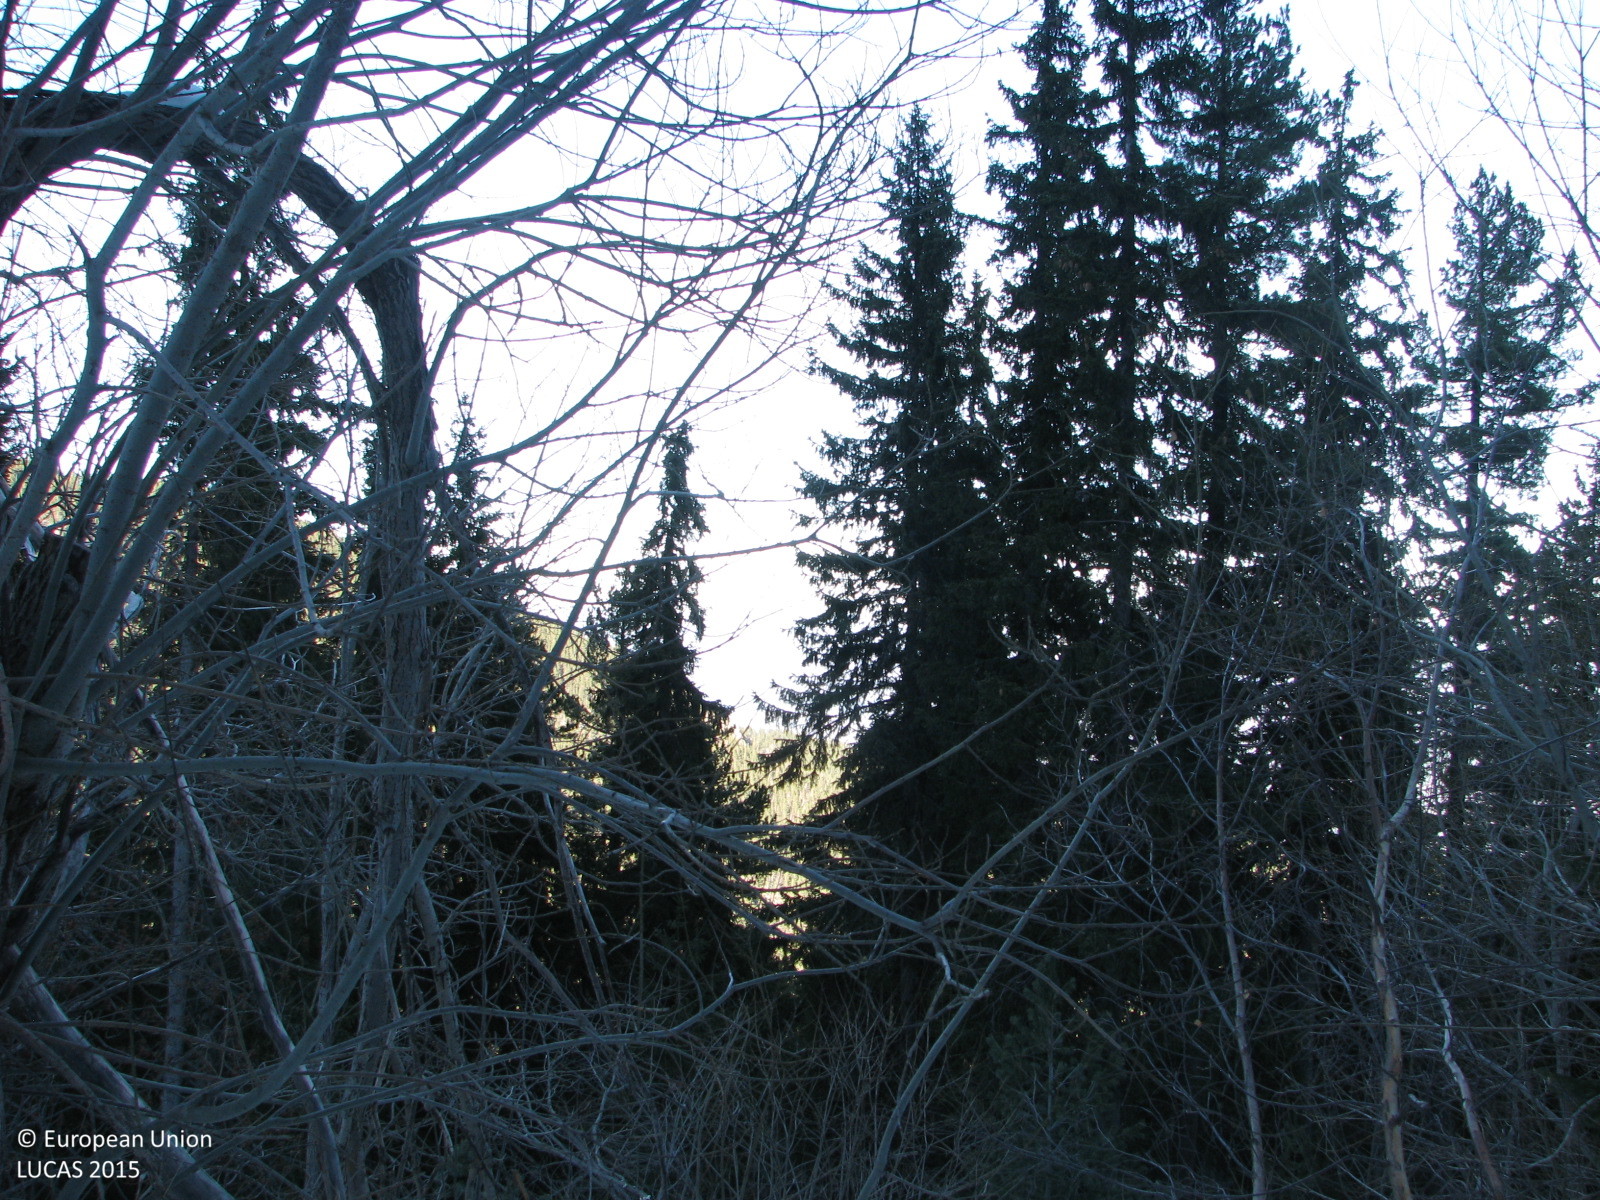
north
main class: Woodland
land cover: Spruce dominated mixed woodland
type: hemiboreal forest and nemoral coniferous forest and mixed broadleaved-coniferous forest
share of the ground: > 75 %
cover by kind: coniferous forest trees 60 %, broadleaved forest trees 25 %, unconsolidated bare surface 15 %
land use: Forestry
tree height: < 5 m
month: December
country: BG
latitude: 42.1942
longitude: 23.8296
